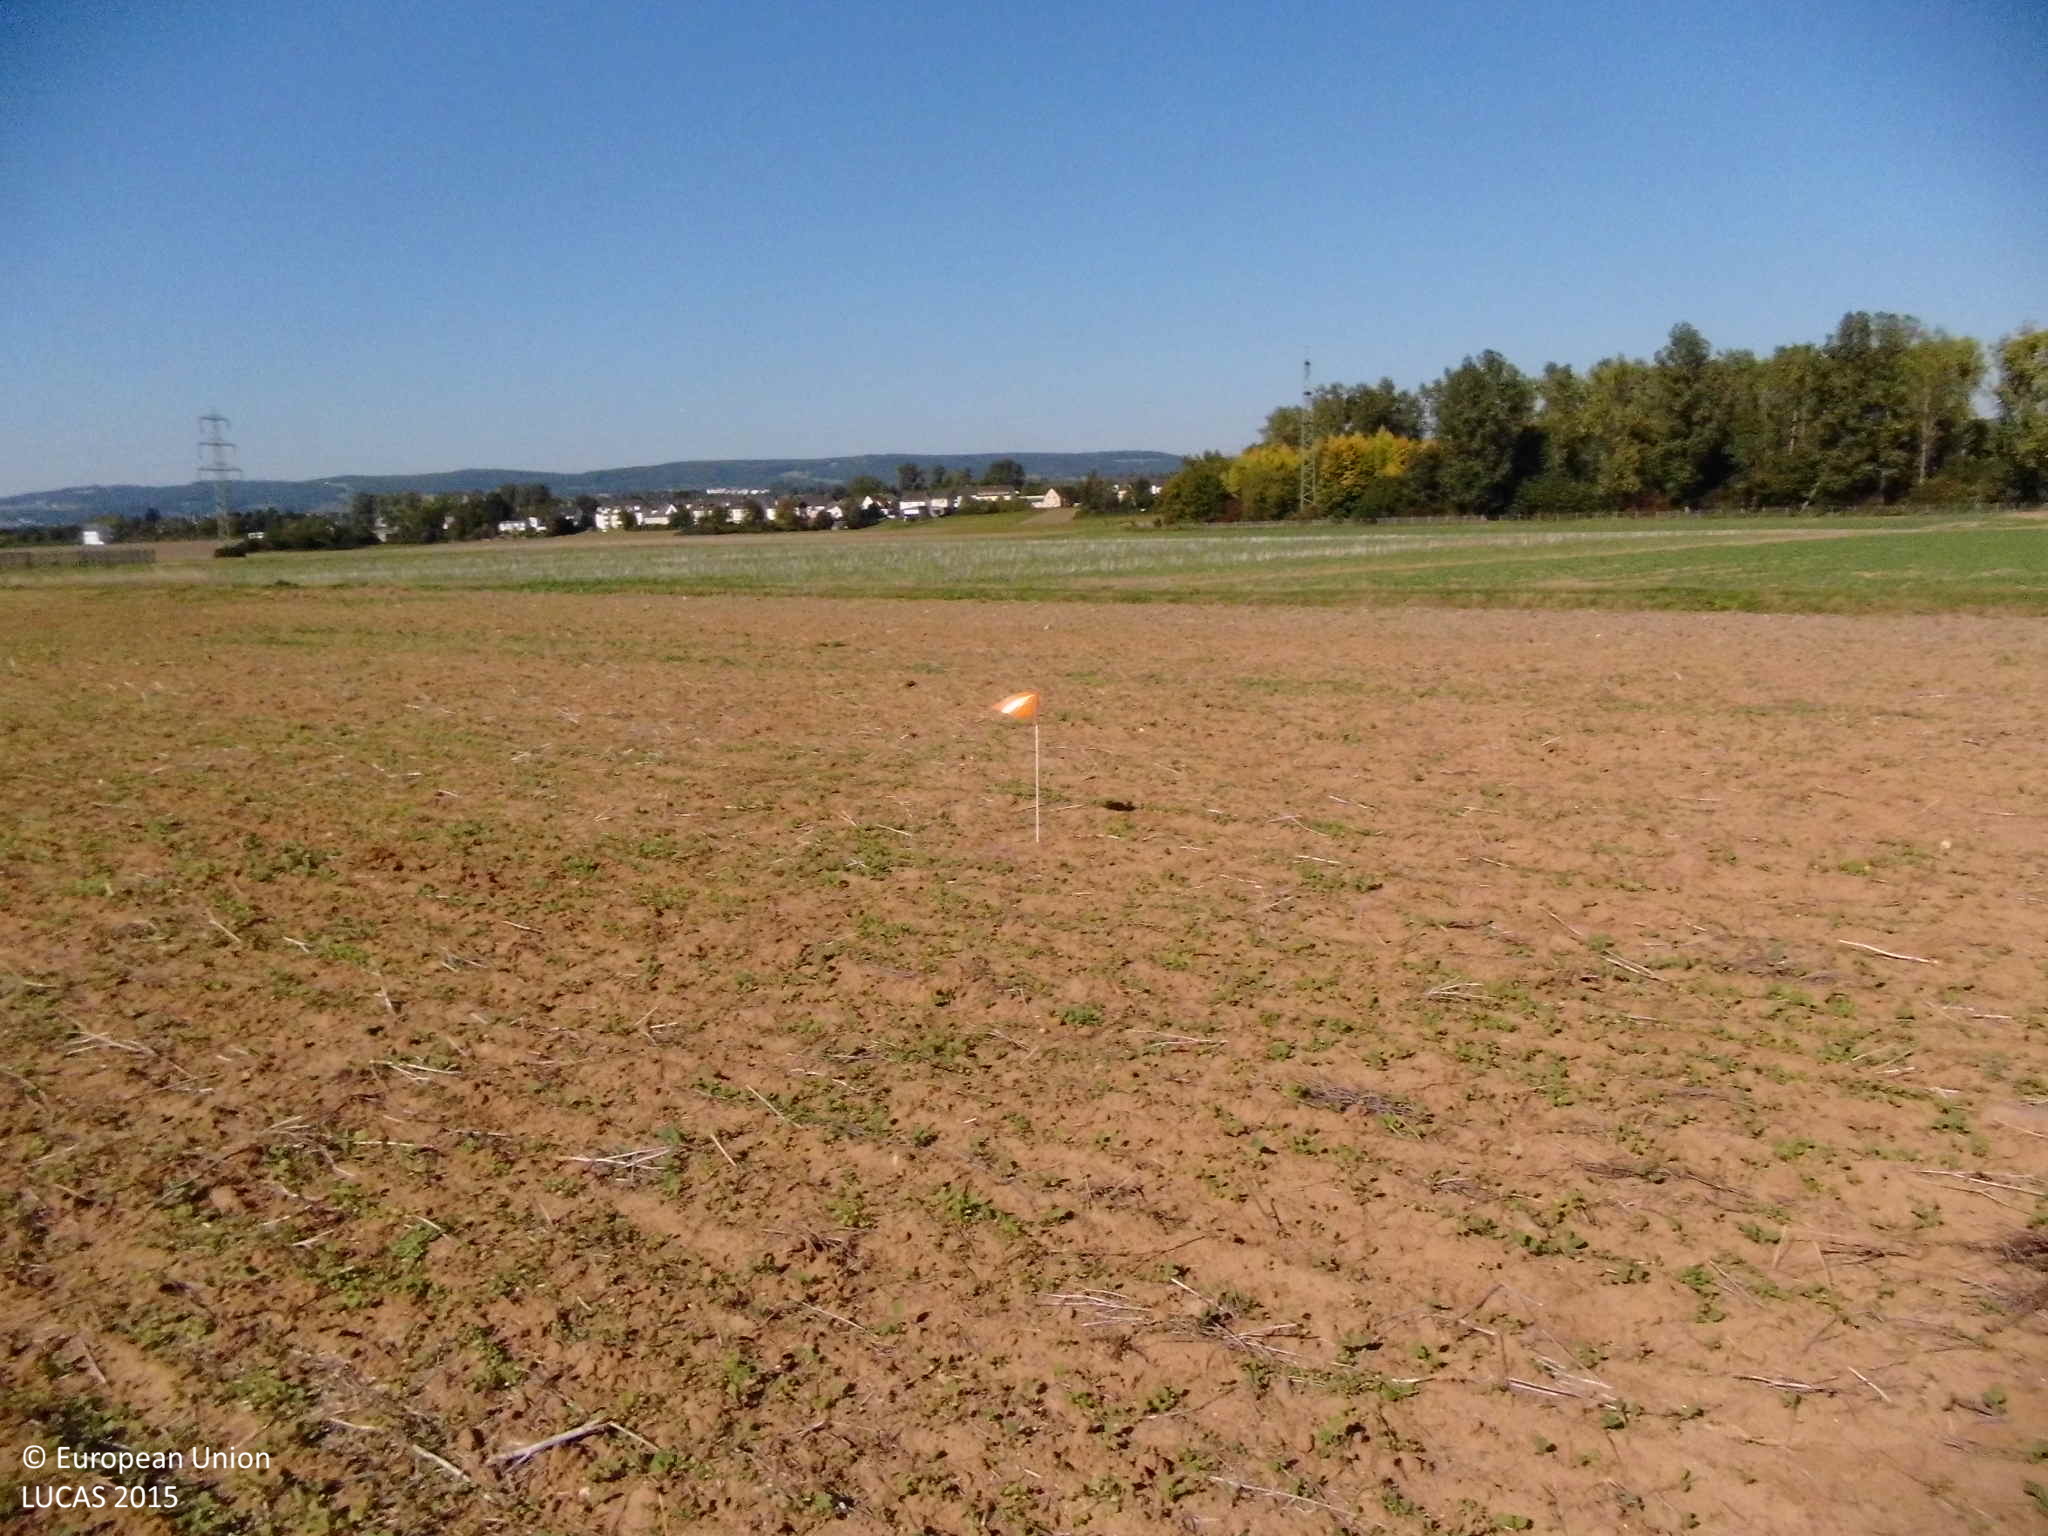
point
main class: Cropland
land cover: Rape and turnip rape
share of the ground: < 10 %
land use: Agriculture (excluding fallow land and kitchen gardens)
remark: Harvested field
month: October
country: DE
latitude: 50.4269
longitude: 7.5087
